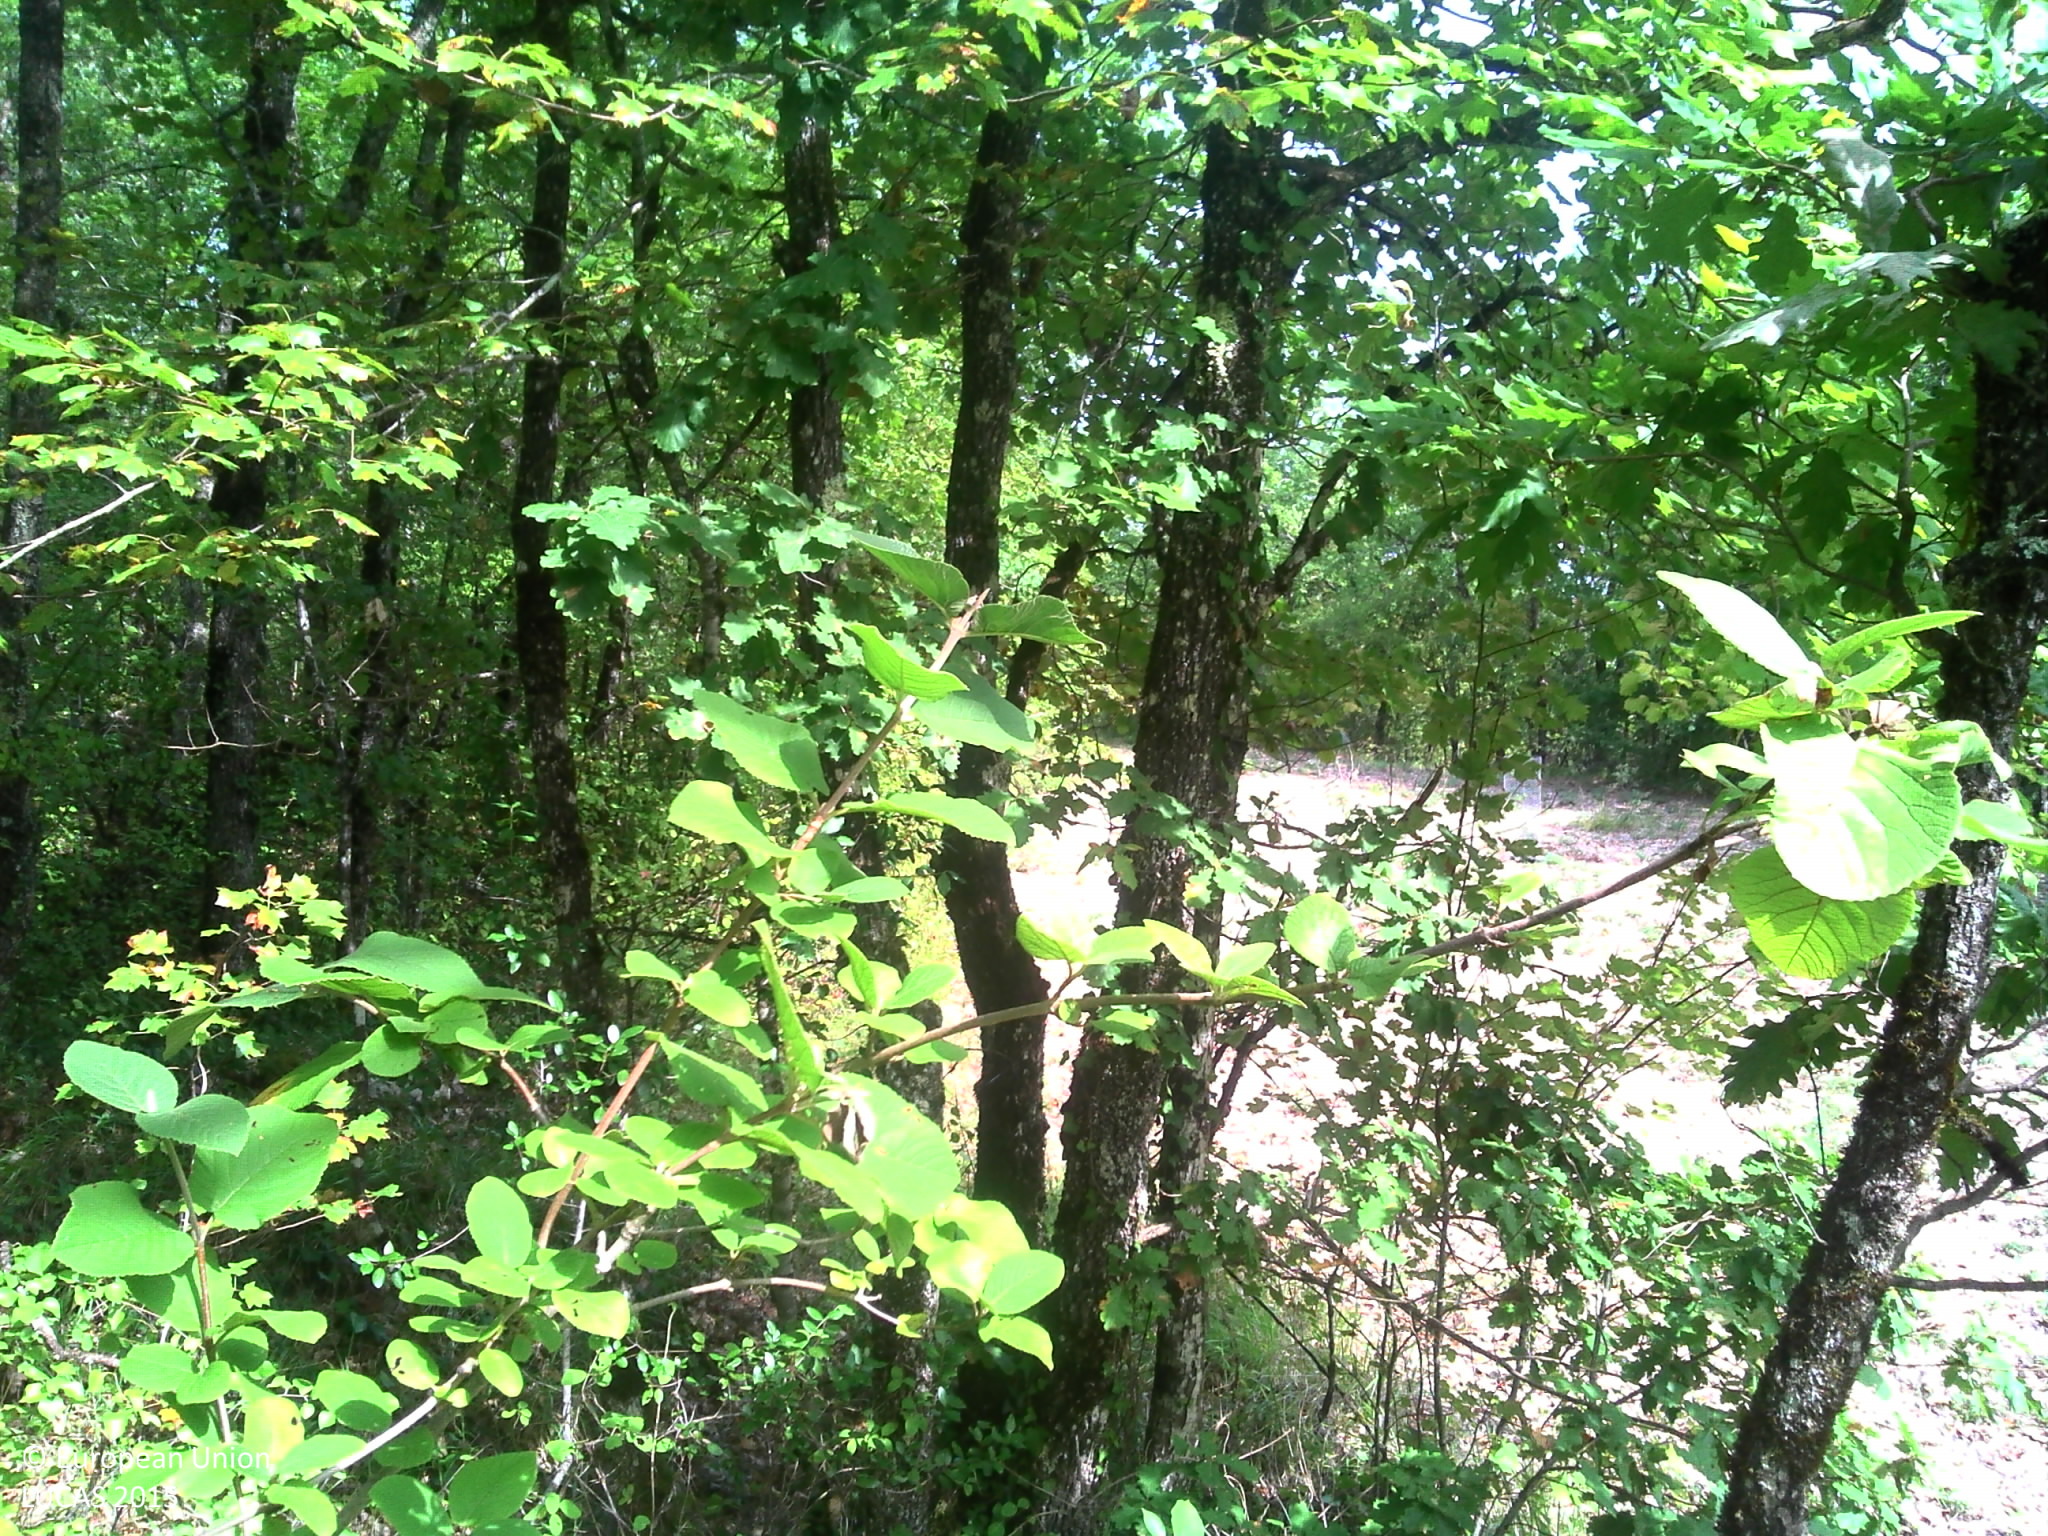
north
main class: Woodland
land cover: Broadleaved woodland
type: thermophilous deciduous forest
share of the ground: > 75 %
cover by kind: broadleaved forest trees 80 %, shrubs 10 %, herbaceous plants 10 %
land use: Forestry
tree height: > 5 m
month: August
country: FR
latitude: 44.3571
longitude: 1.2023
